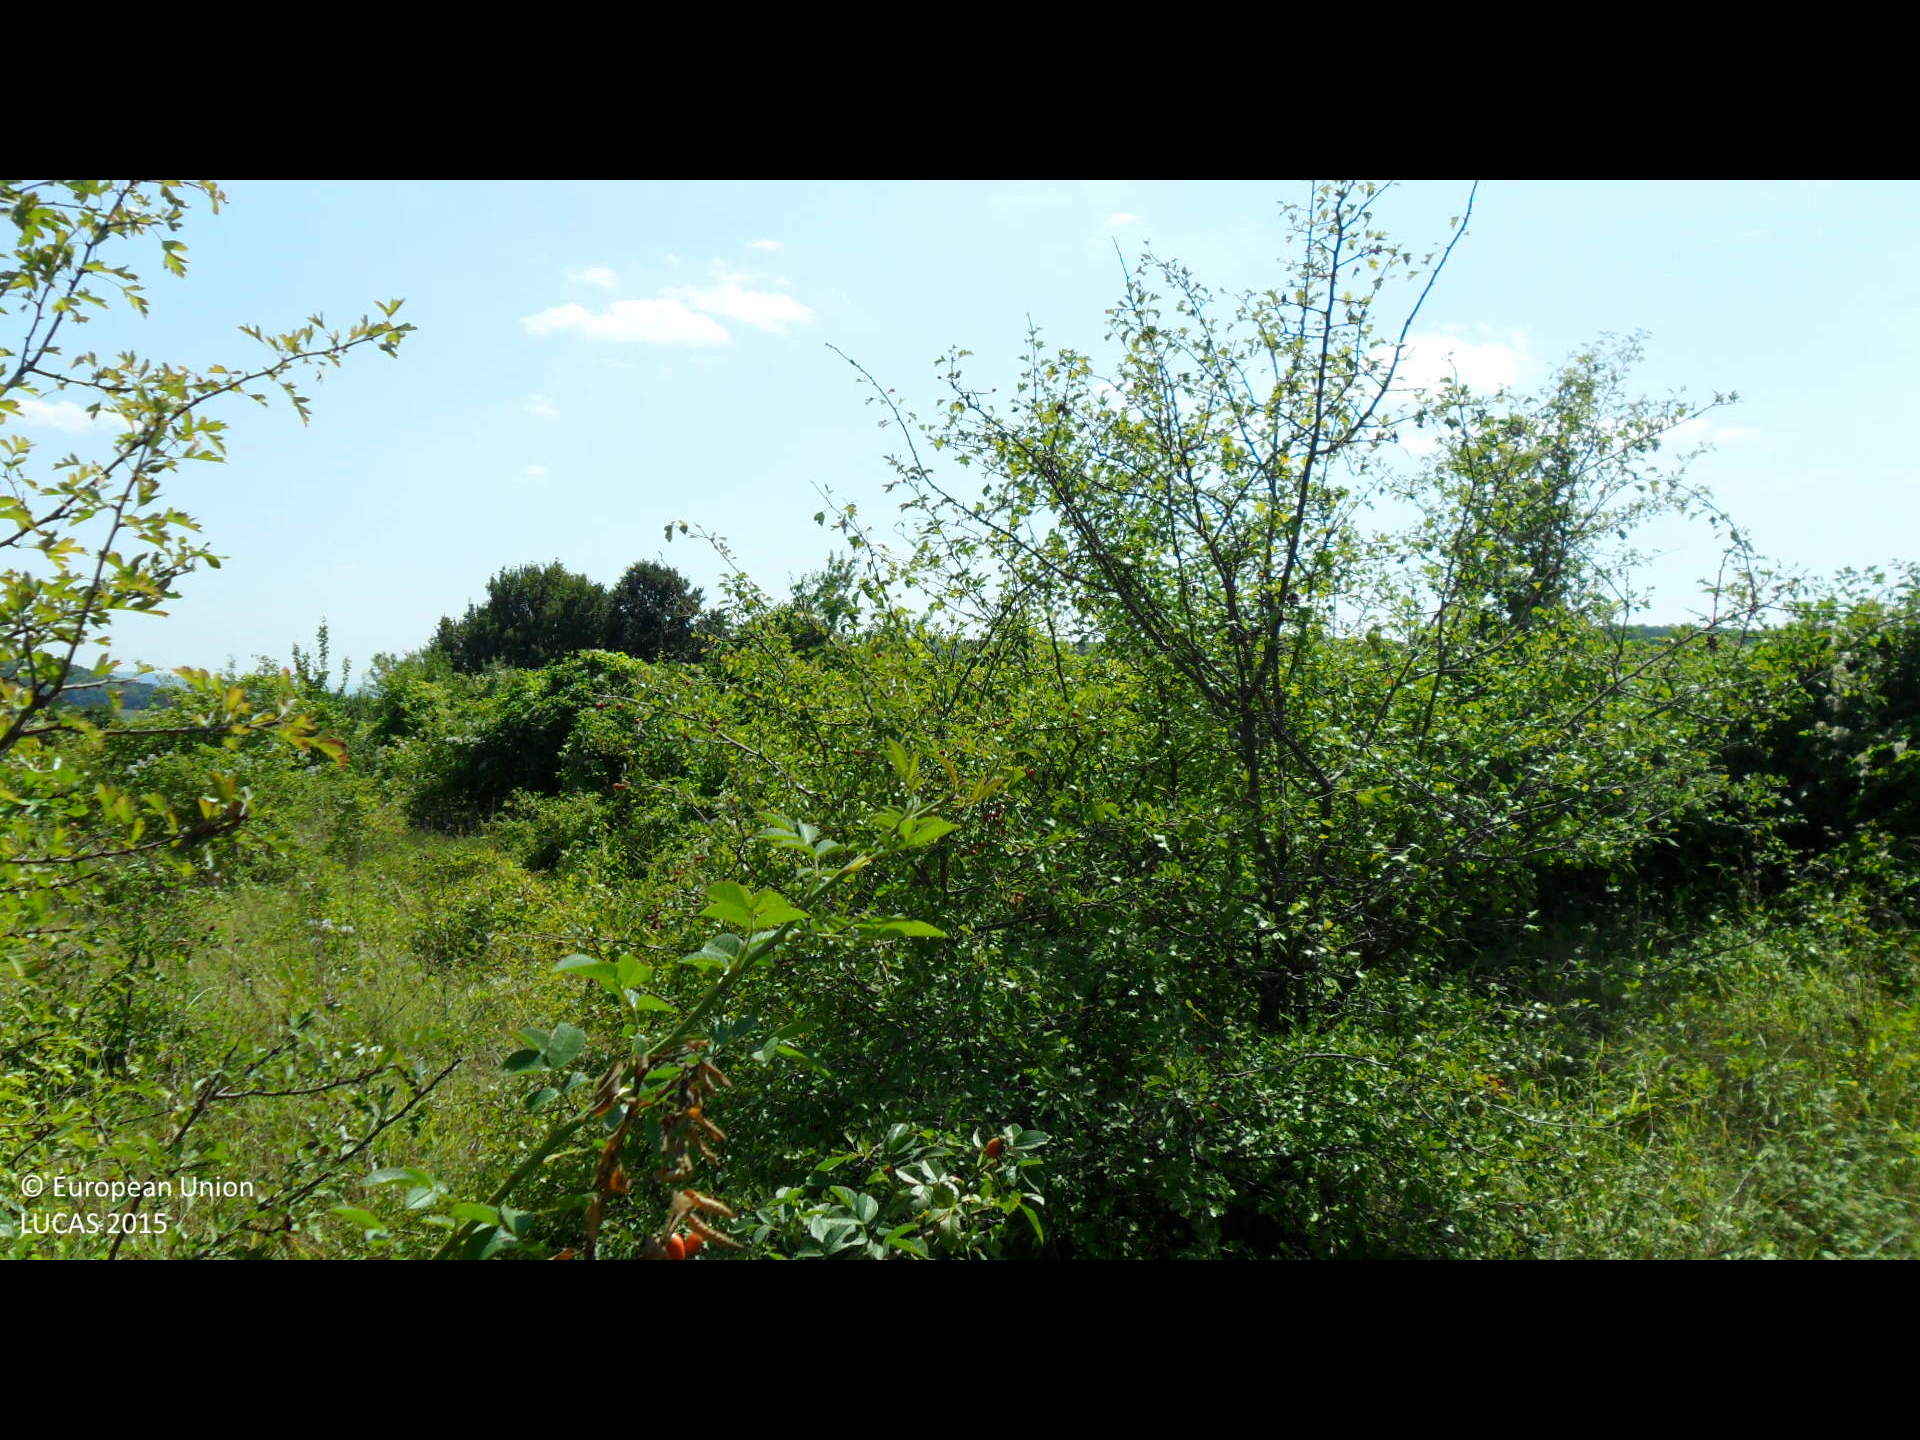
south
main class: Shrubland
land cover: Shrubland without tree cover
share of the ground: > 75 %
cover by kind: shrubs 75 %, herbaceous plants 25 %
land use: Semi-natural and natural areas not in use
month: August
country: BG
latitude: 43.4630
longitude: 26.2526
